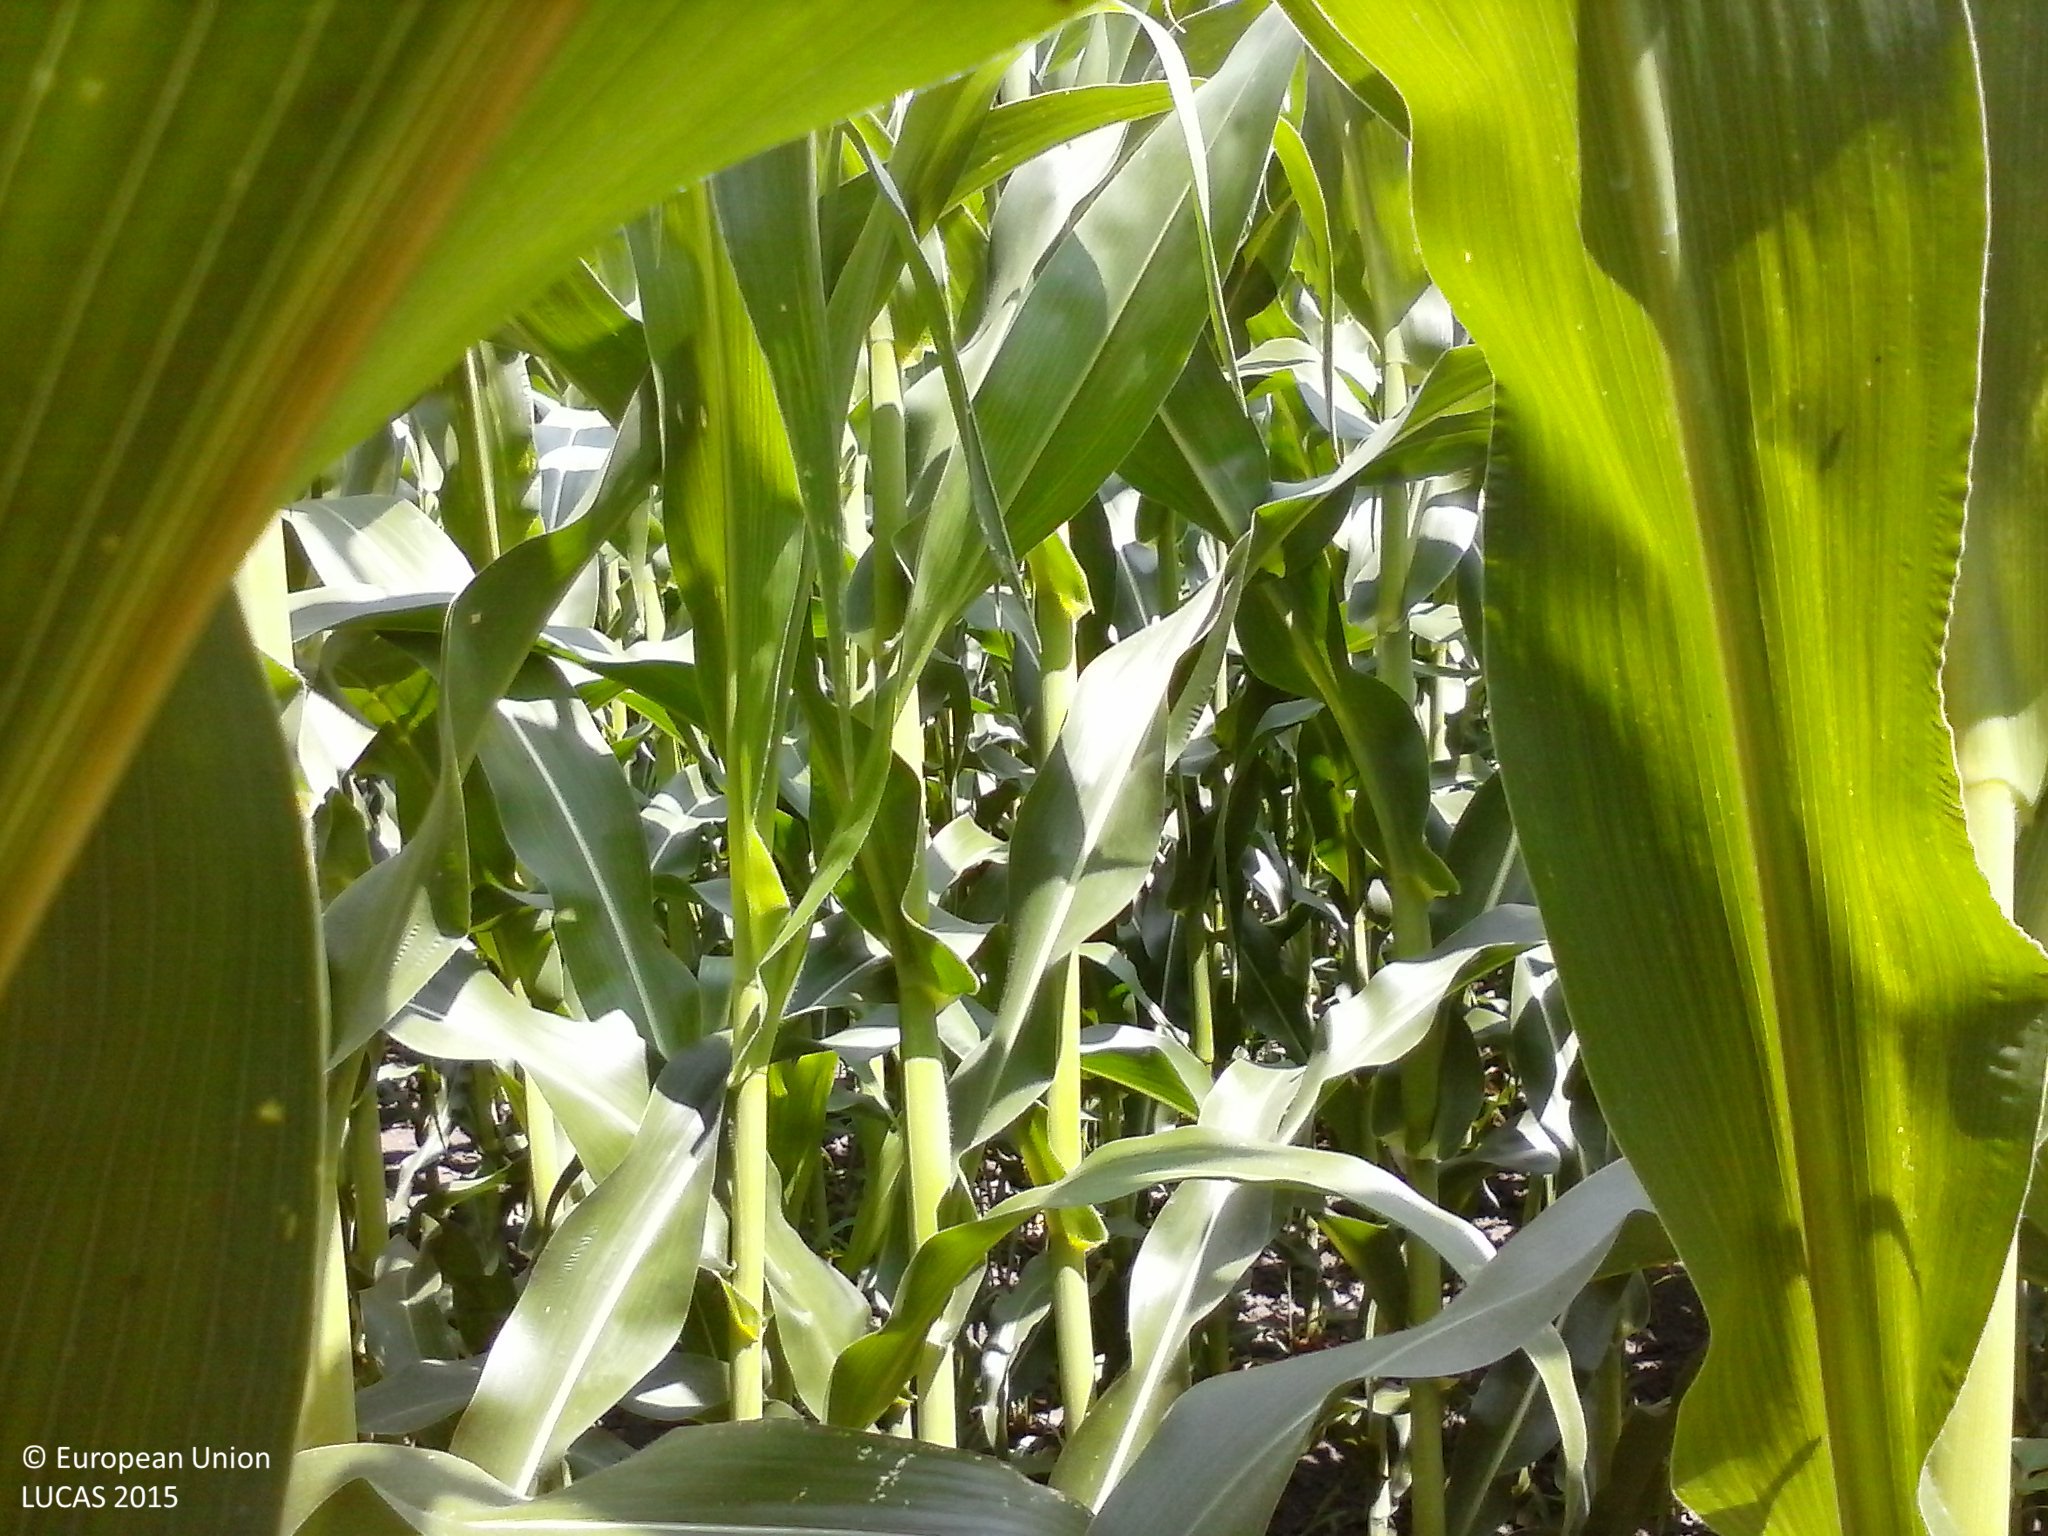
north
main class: Cropland
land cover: Maize
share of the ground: > 75 %
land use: Agriculture (excluding fallow land and kitchen gardens)
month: June
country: HU
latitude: 46.2183
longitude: 19.4925
